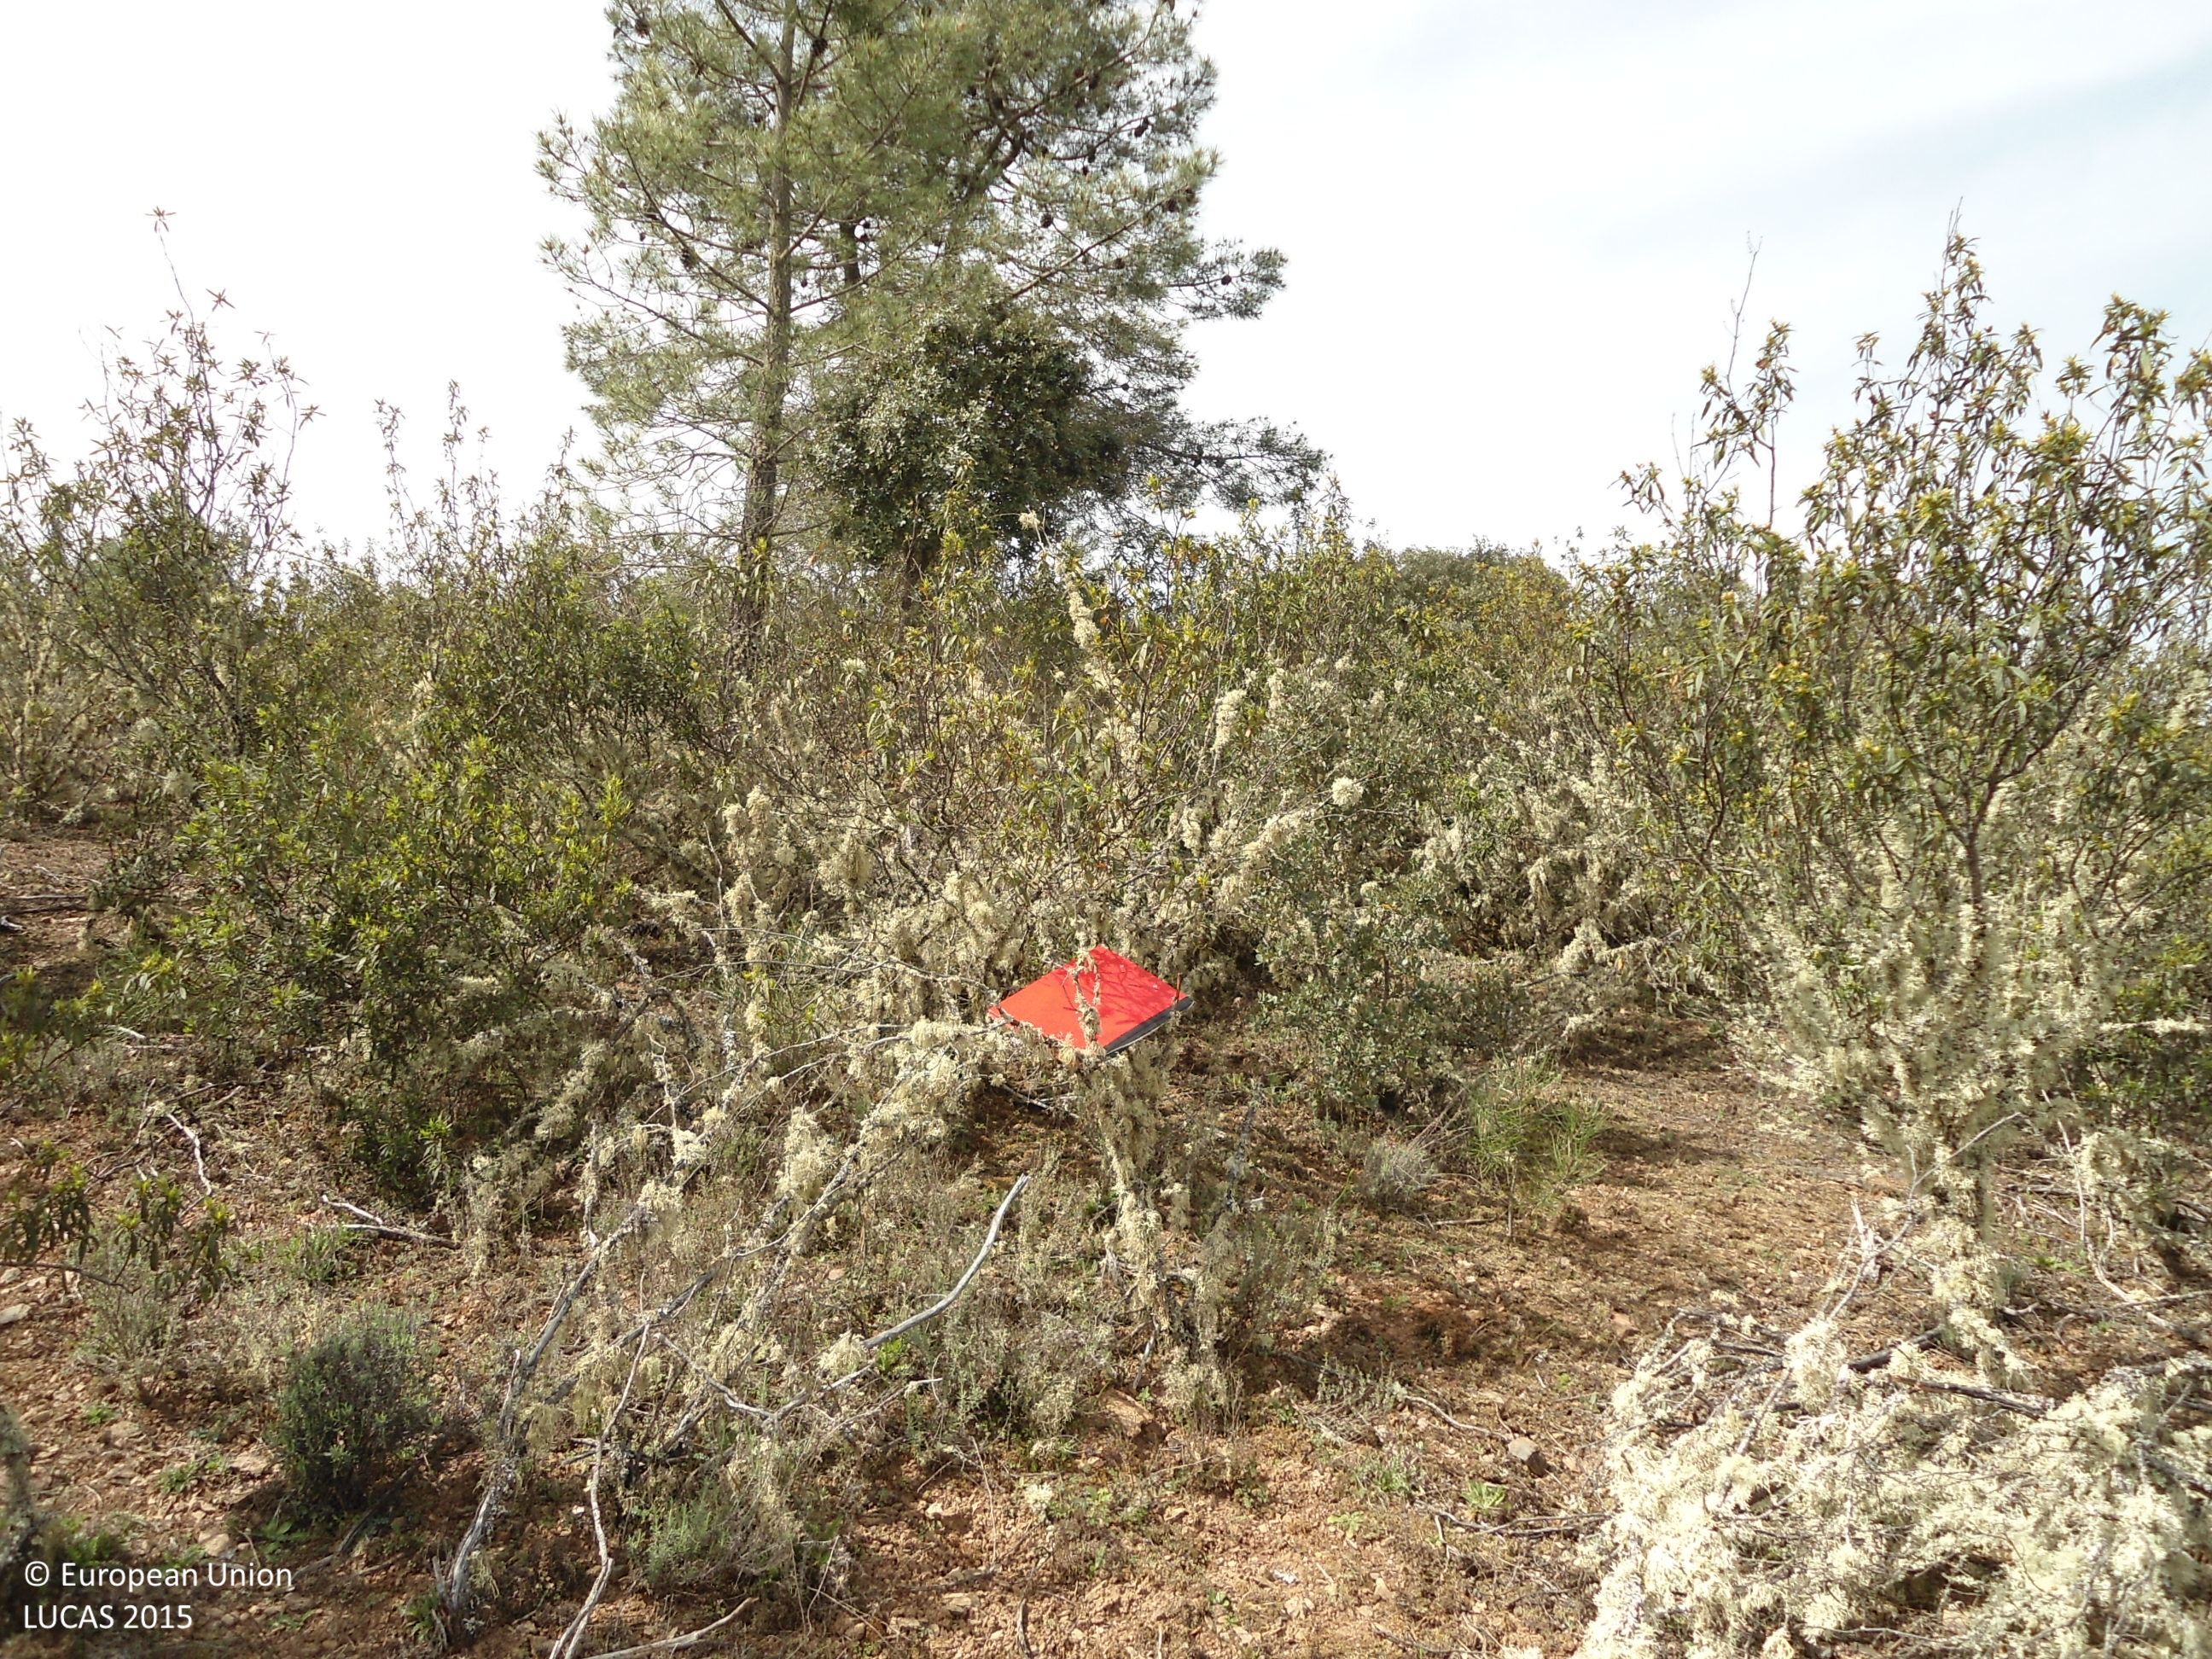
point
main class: Shrubland
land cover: Shrubland with sparse tree cover
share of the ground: > 75 %
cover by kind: shrubs 95 %, coniferous forest trees 5 %
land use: Forestry
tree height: < 5 m
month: April
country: ES
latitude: 41.8244
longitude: -6.4933
